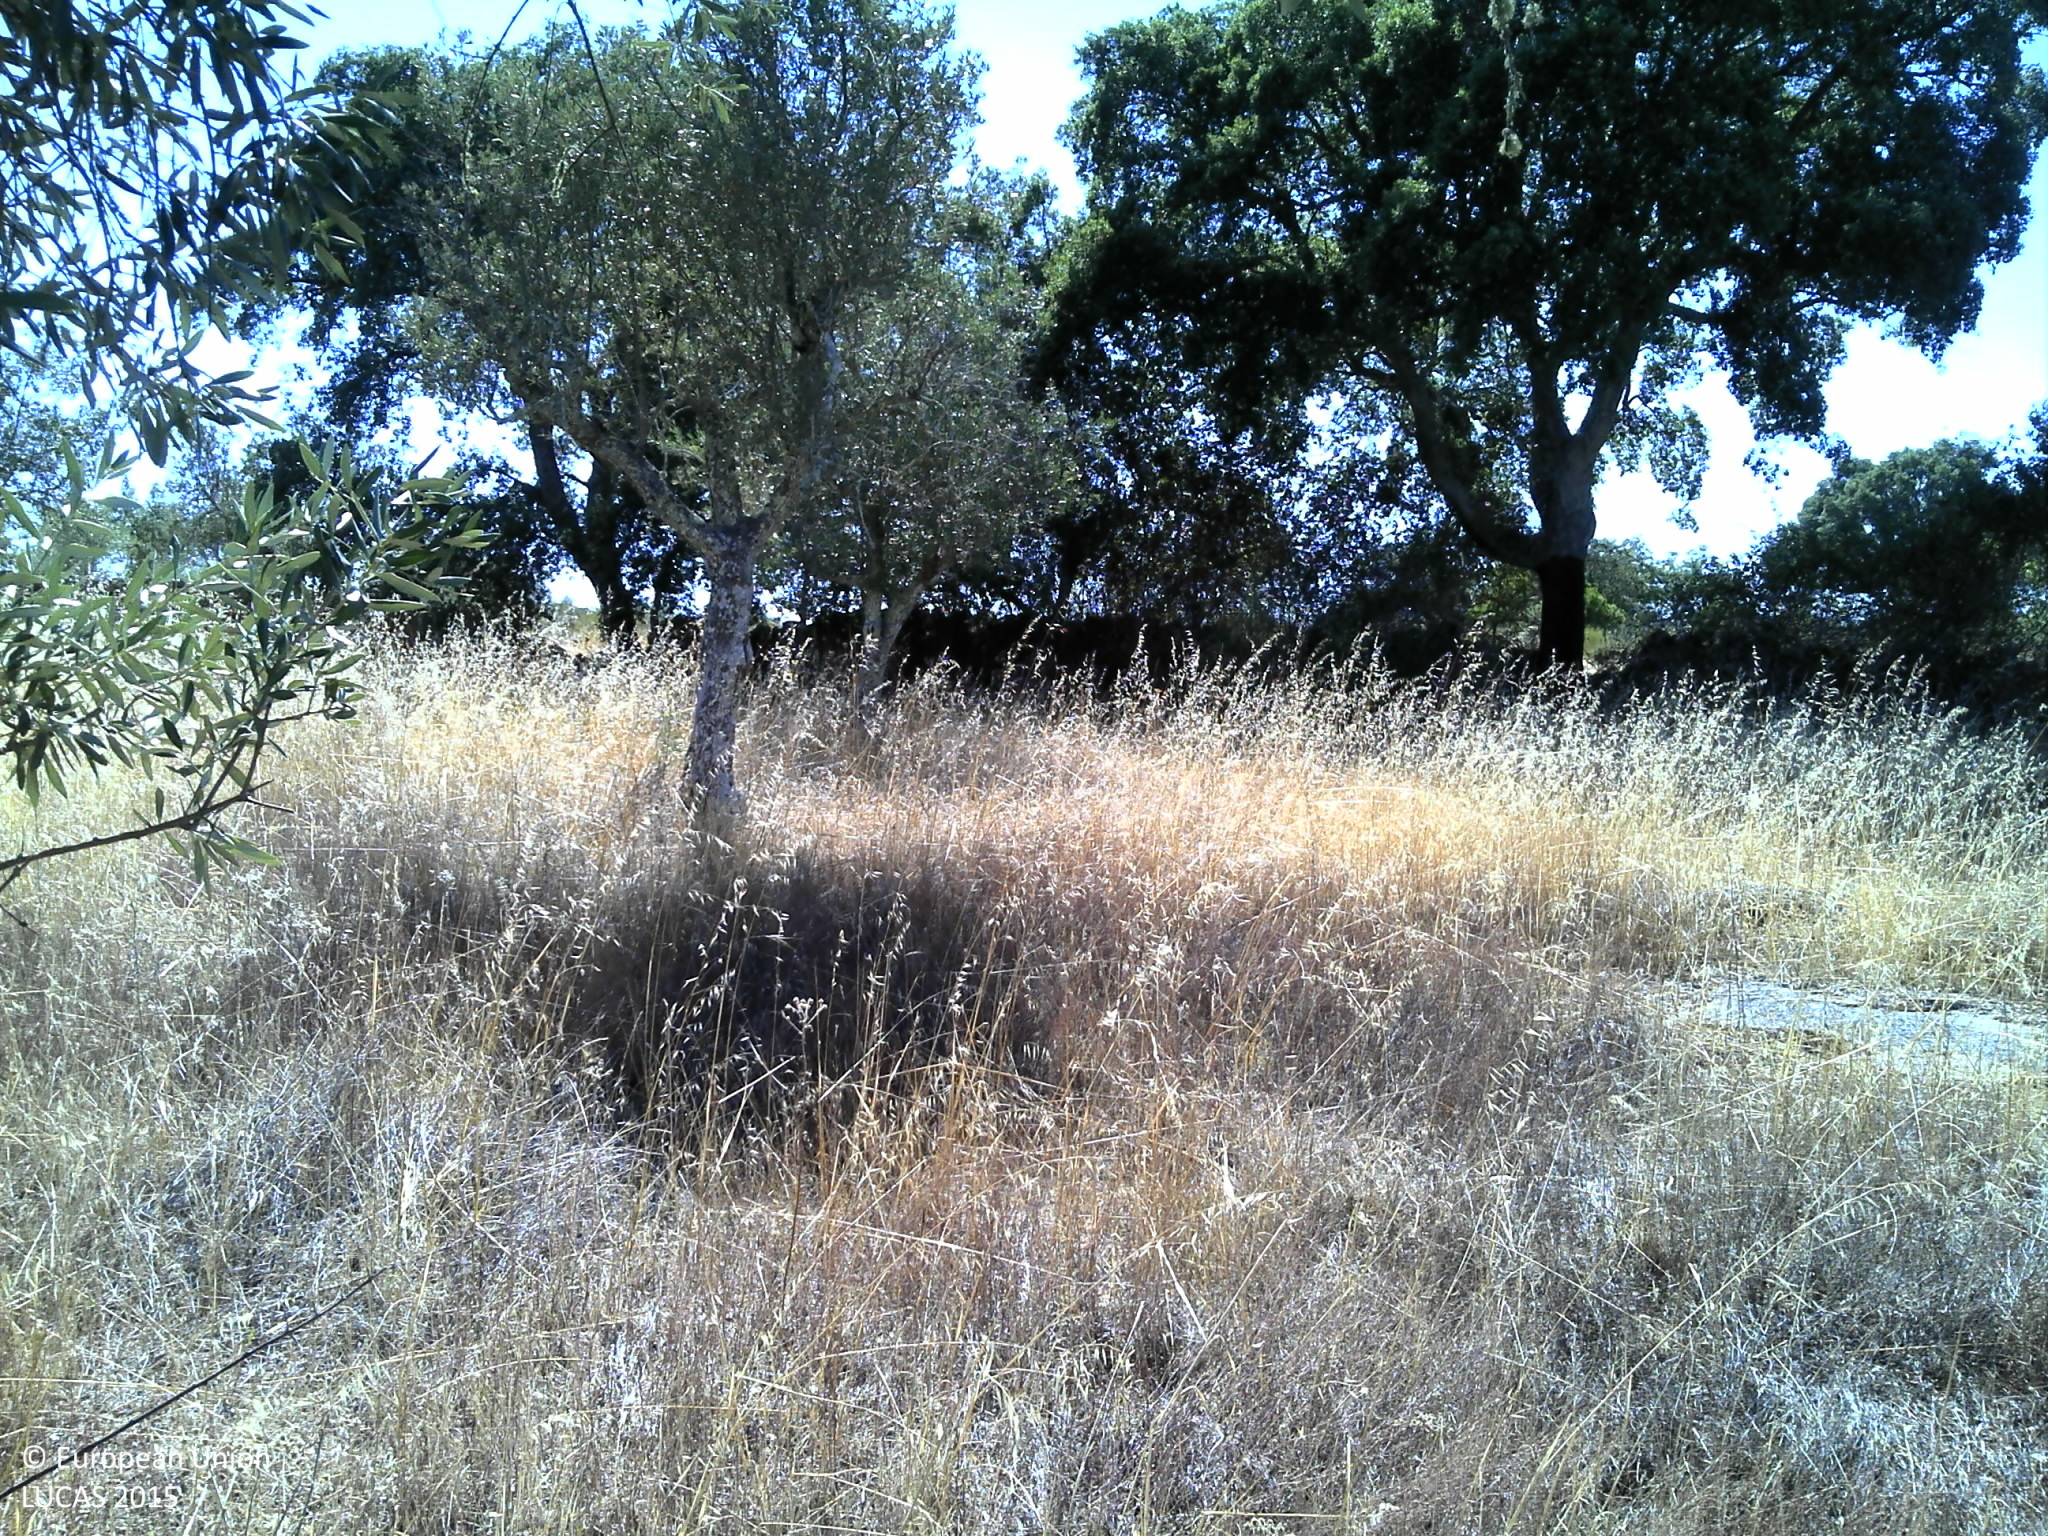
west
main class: Cropland
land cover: Olive groves
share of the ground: 10 - 25 %
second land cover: Grassland without tree/shrub cover
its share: 10 - 25 %
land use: Agriculture (excluding fallow land and kitchen gardens)
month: August
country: PT
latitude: 39.5063
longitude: -7.5275
